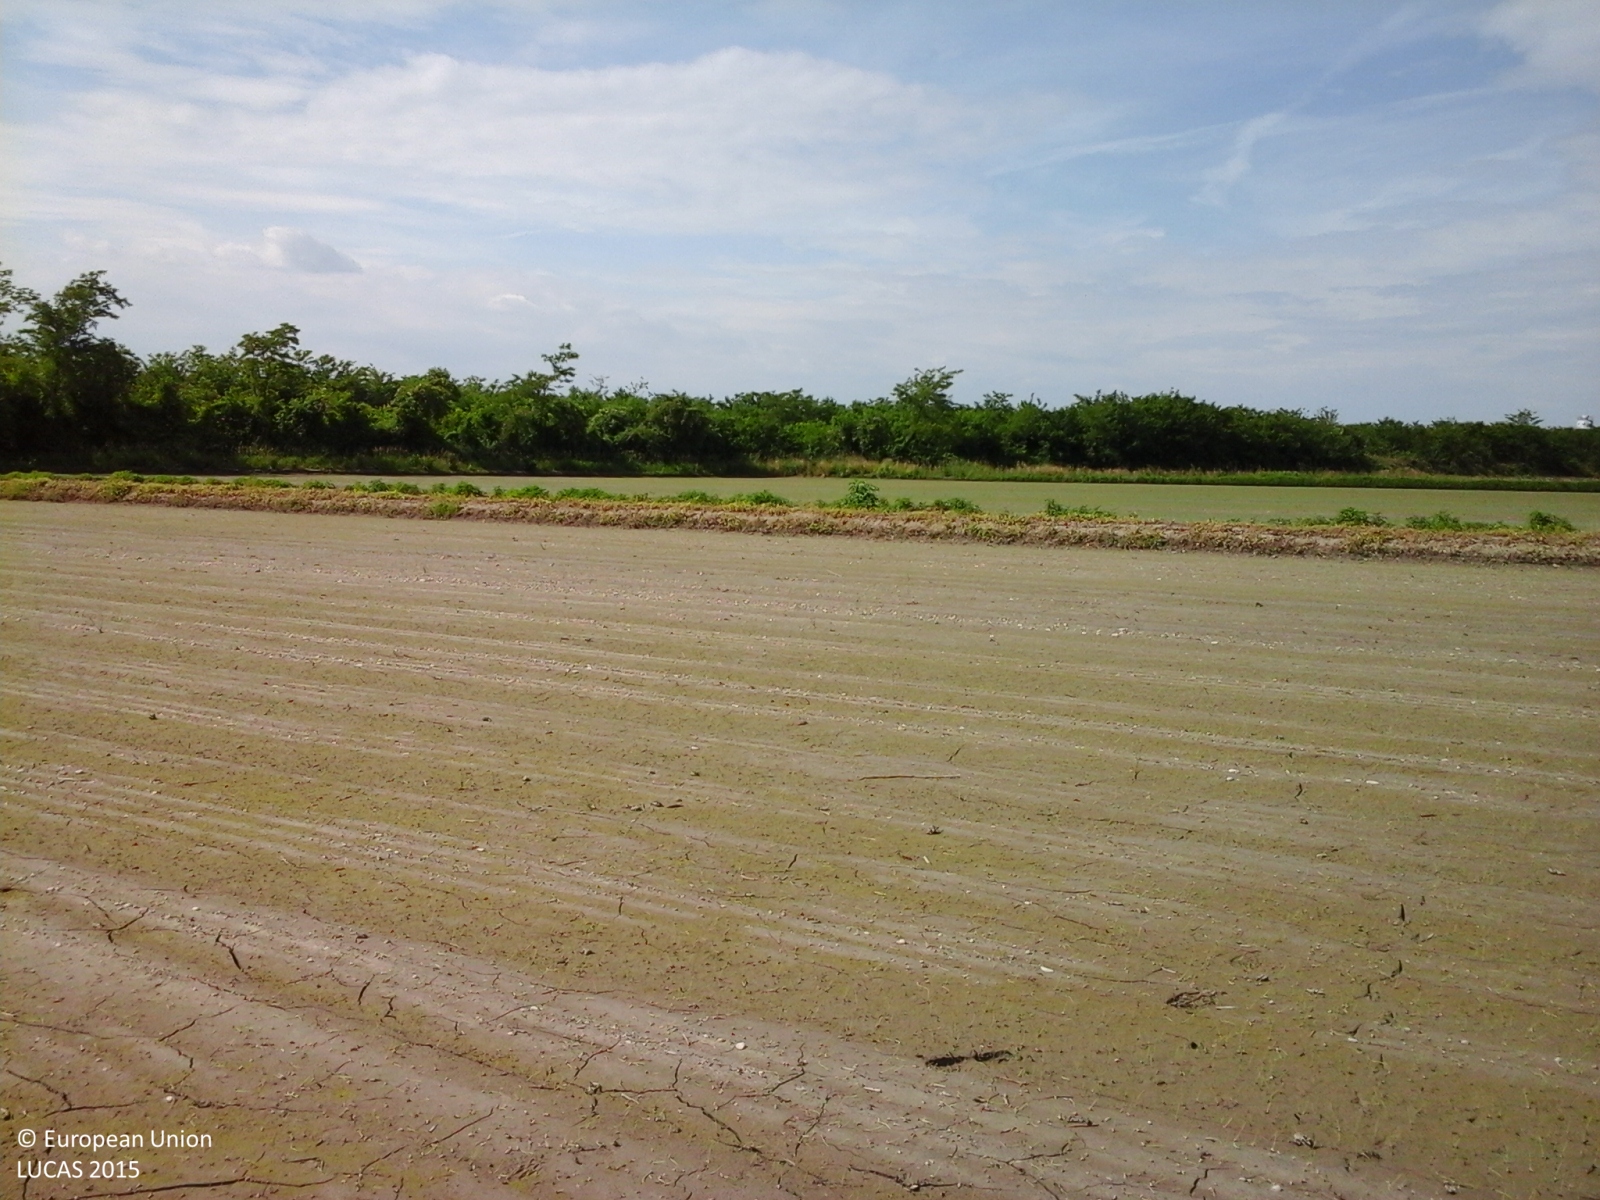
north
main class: Cropland
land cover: Rice
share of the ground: < 10 %
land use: Agriculture (excluding fallow land and kitchen gardens)
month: May
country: IT
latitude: 45.3269
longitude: 8.2041
